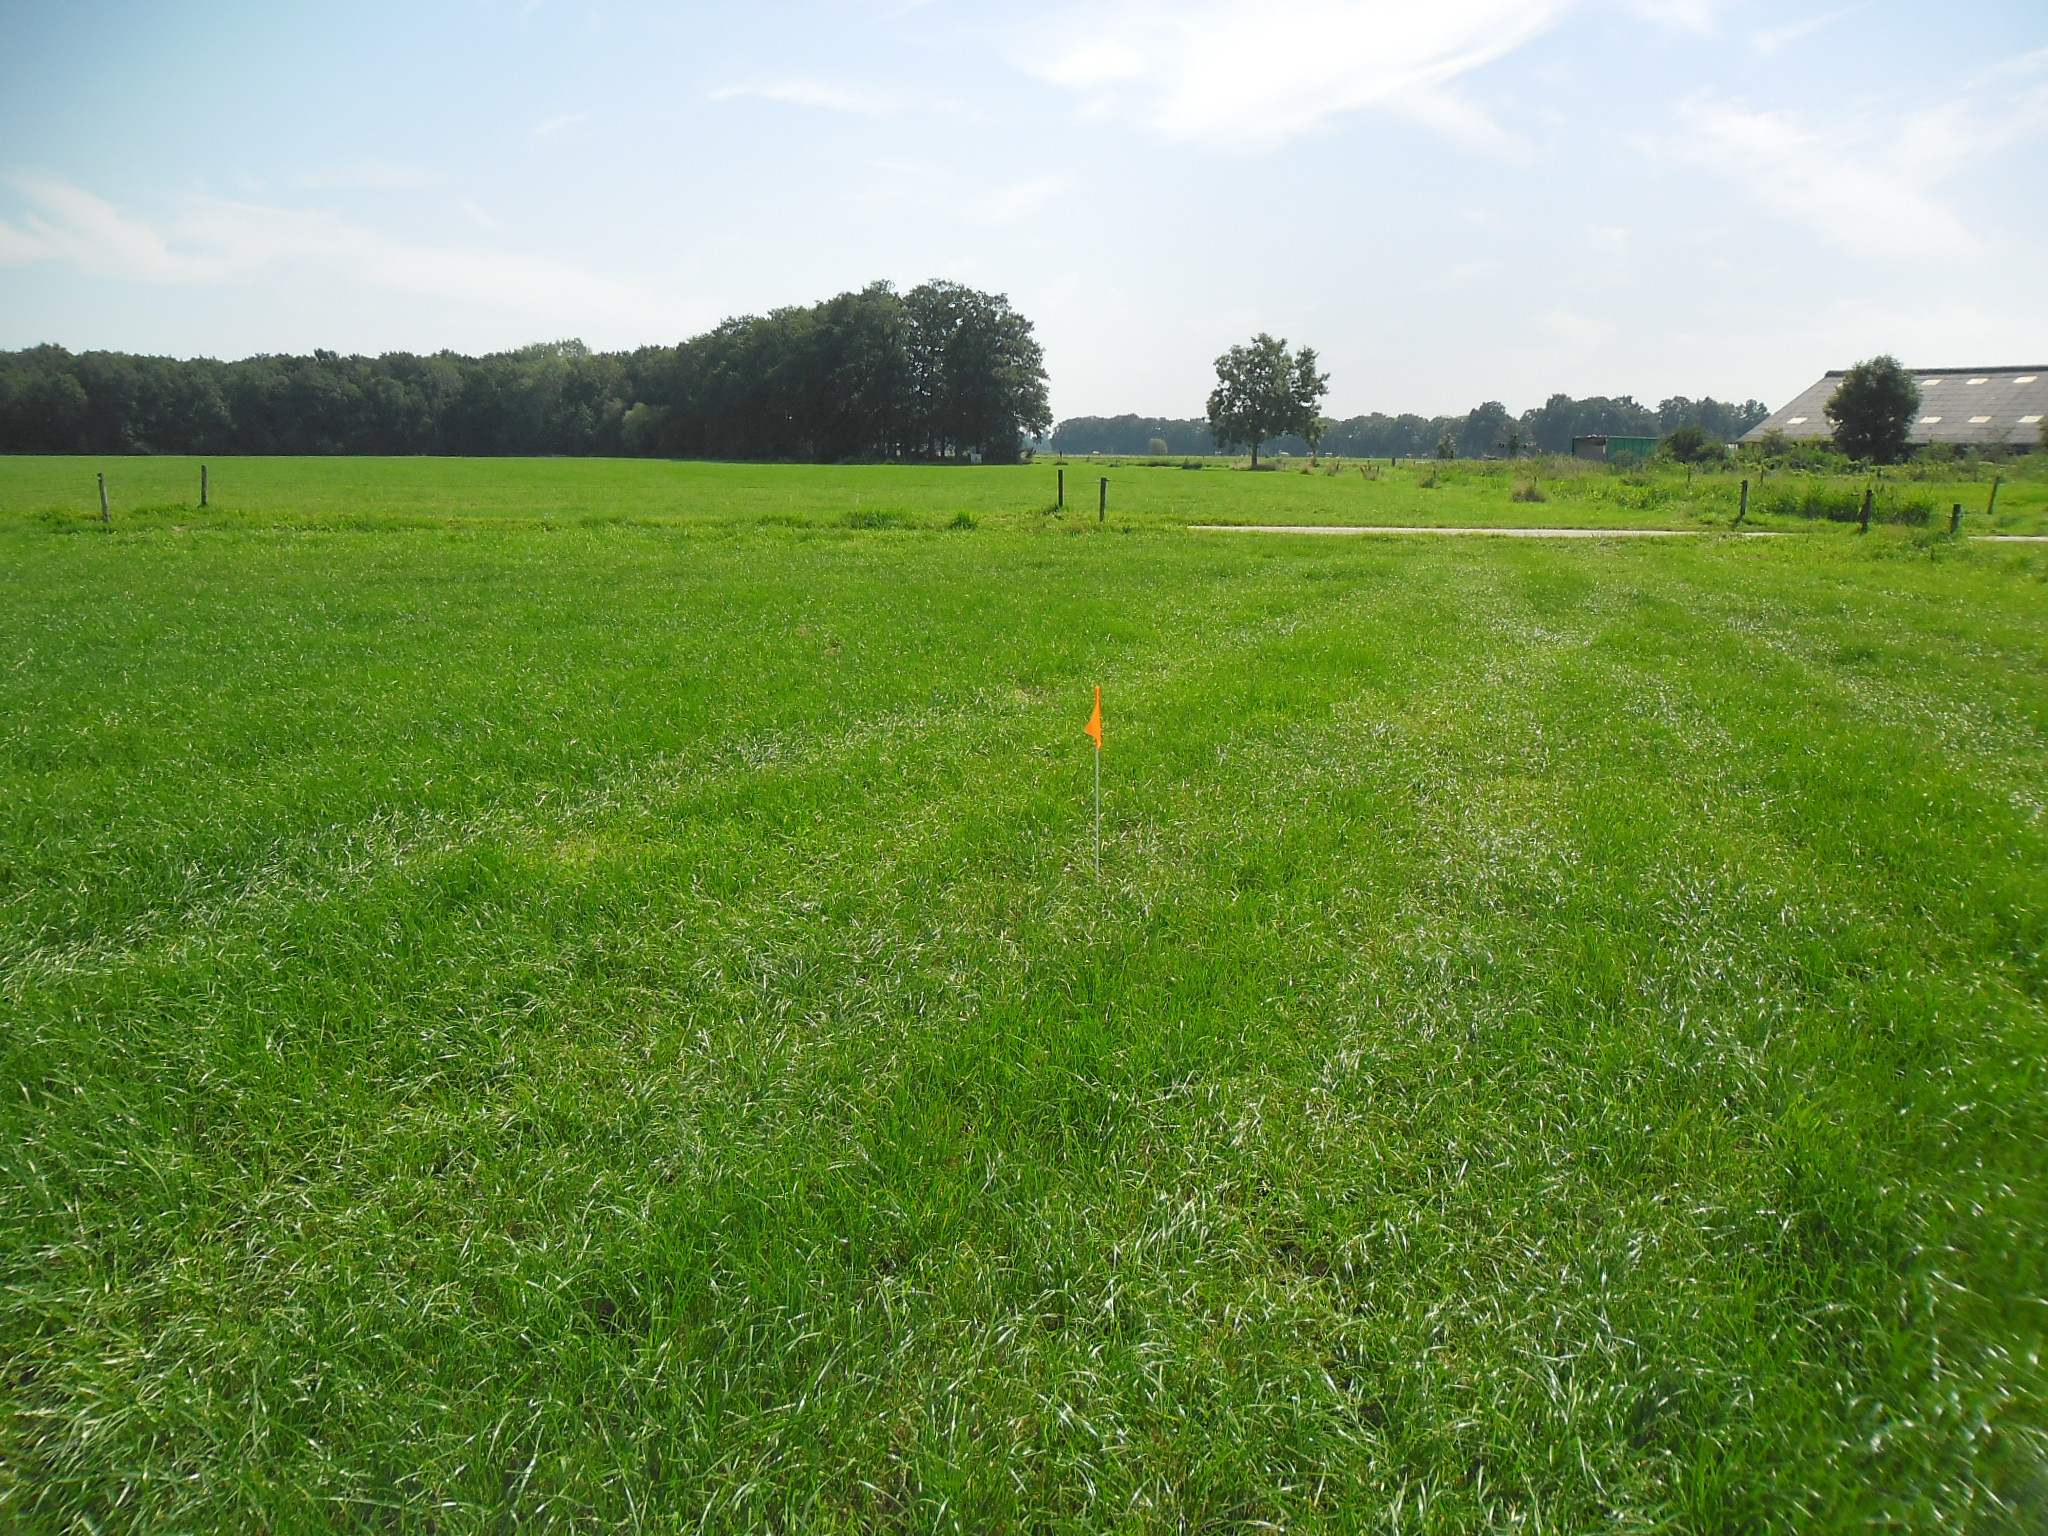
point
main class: Grassland
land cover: Grassland without tree/shrub cover
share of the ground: > 75 %
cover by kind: herbaceous plants 100 %
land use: Agriculture (excluding fallow land and kitchen gardens)
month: August
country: NL
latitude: 52.4064
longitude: 6.1923
